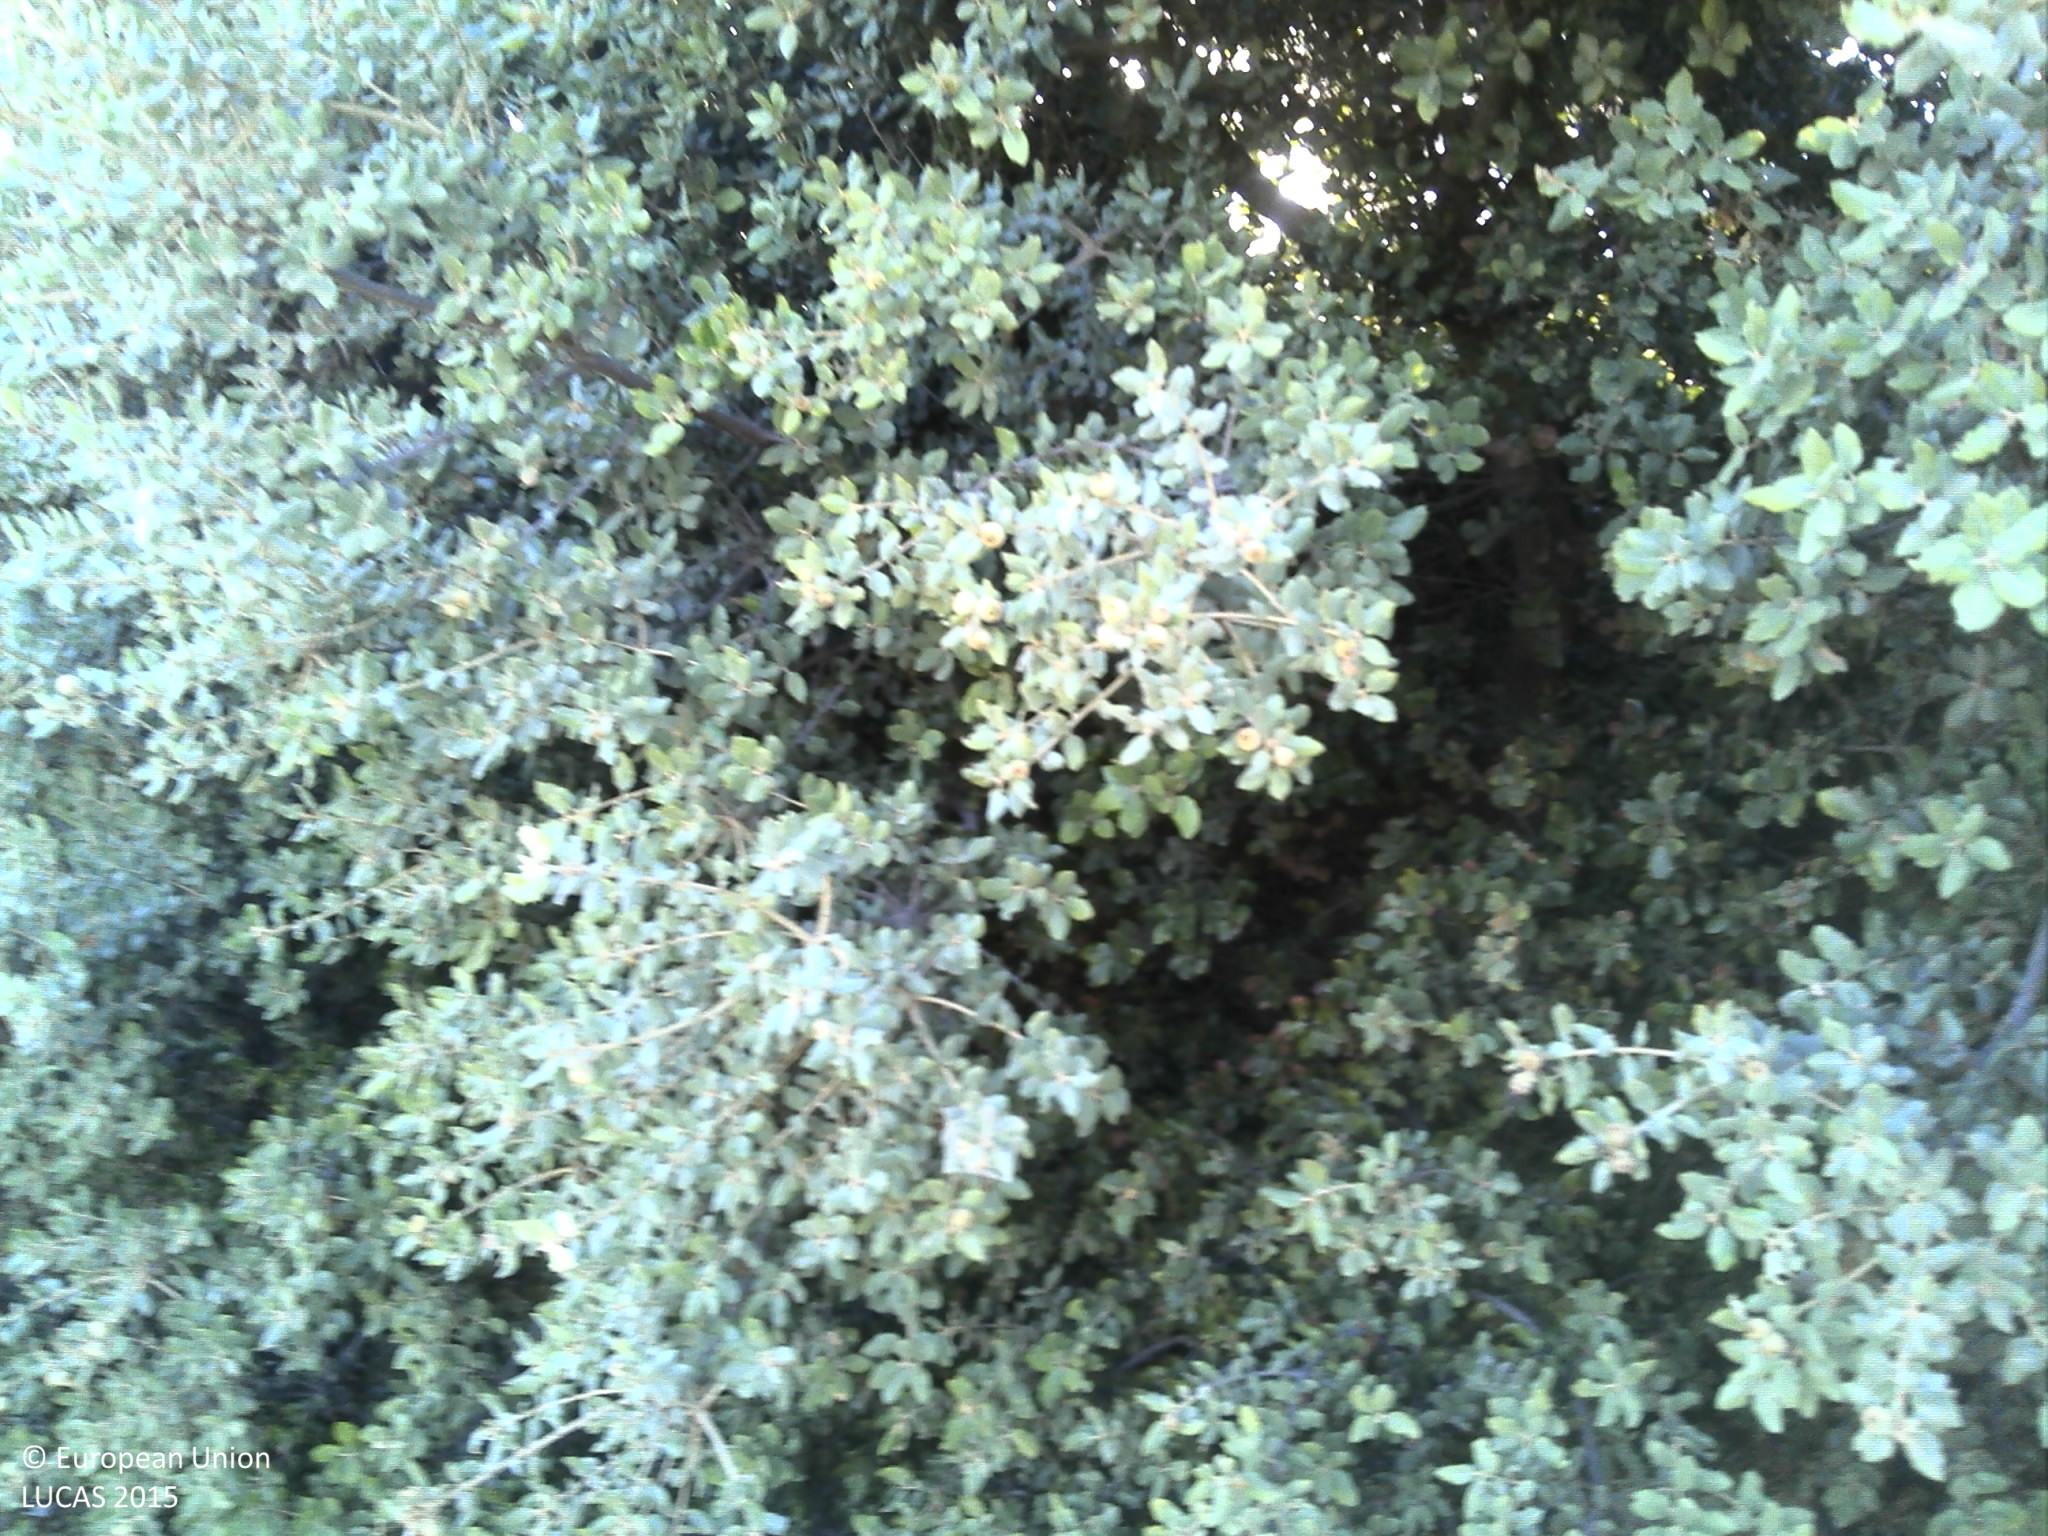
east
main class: Cropland
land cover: Vineyards
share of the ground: < 10 %
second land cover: Other bare soil
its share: > 75 %
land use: Agriculture (excluding fallow land and kitchen gardens)
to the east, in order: Tracks; Vineyards; Other bare soil; Vineyards; Tracks; Dry stone walls; Nuts trees; Vineyards; Artificial constructions in urban areas; Olive groves; Vineyards; Dry stone walls; Olive groves; Vineyards; Tracks
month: July
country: PT
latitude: 41.2254
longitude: -7.4059
